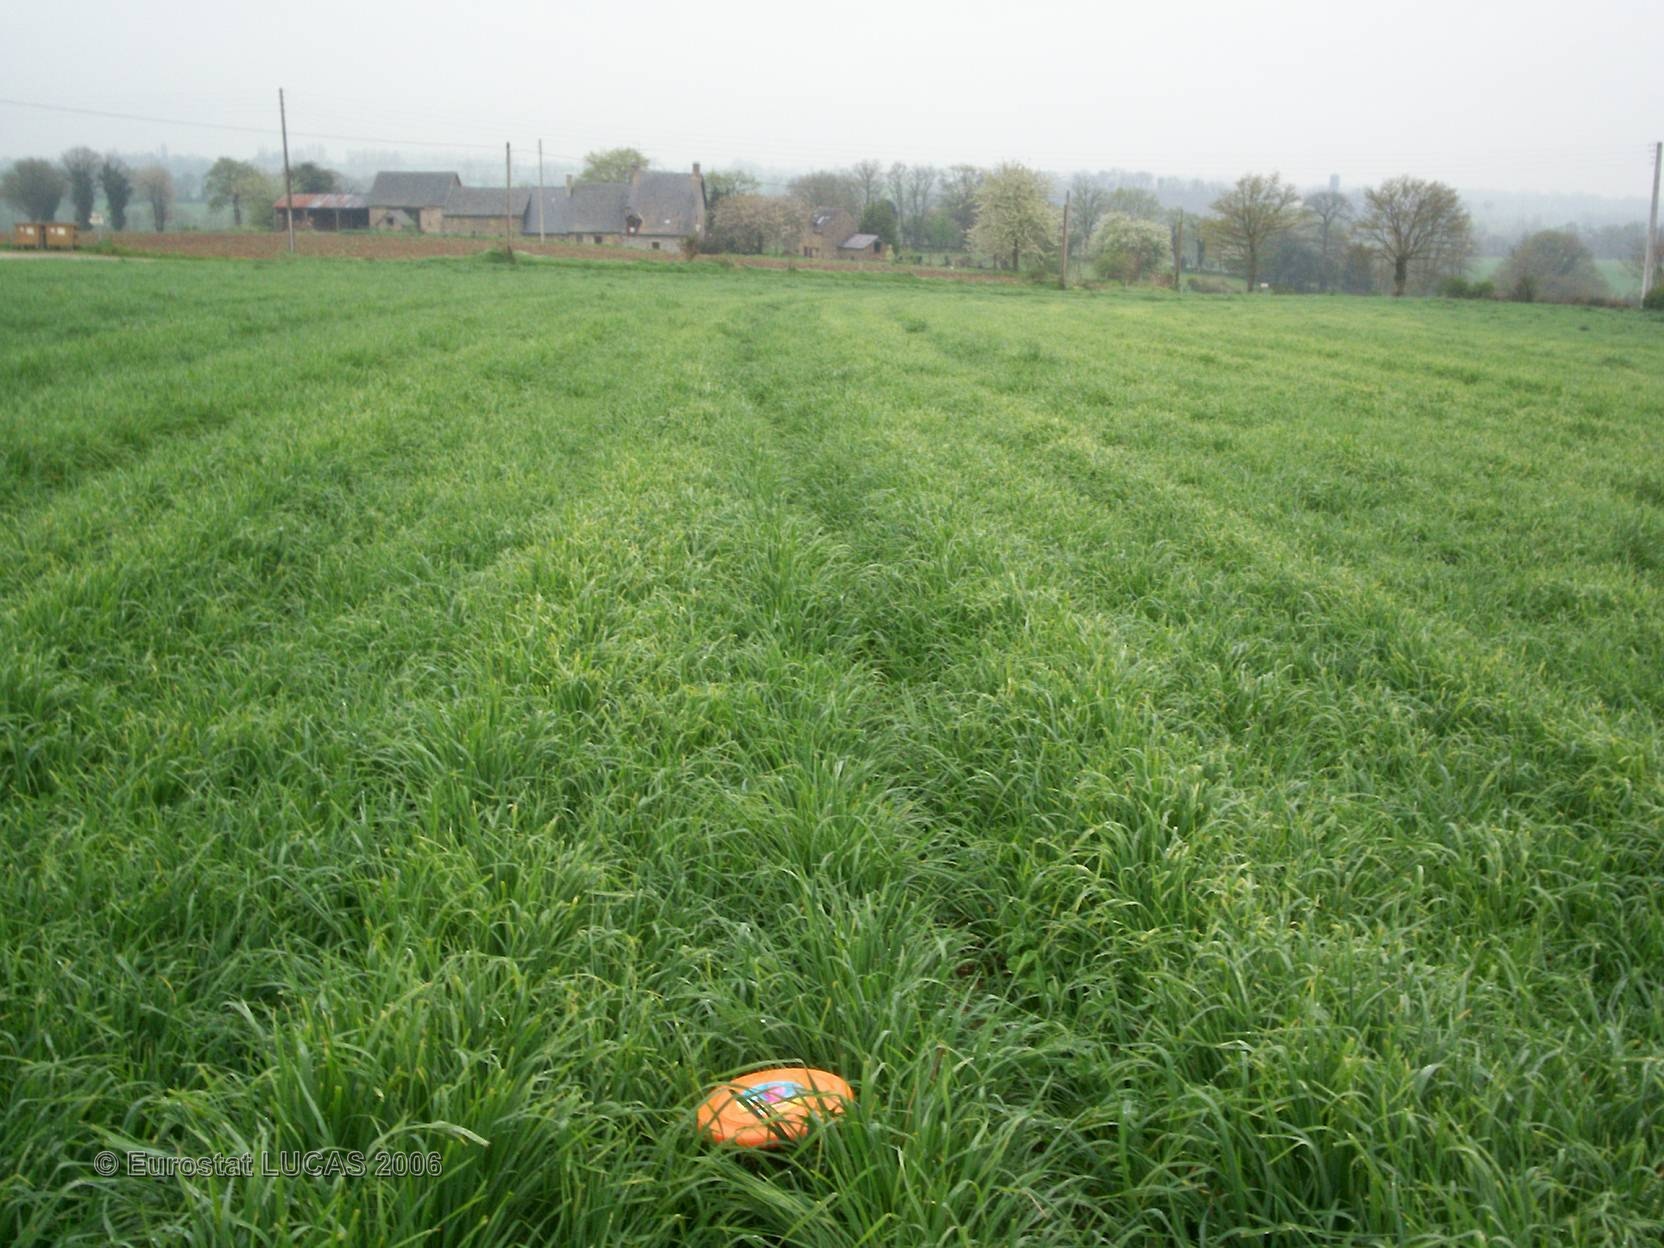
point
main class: Grassland
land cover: Grassland without tree/shrub cover
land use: Agriculture (excluding fallow land and kitchen gardens)
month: April
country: FR
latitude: 48.2494
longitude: -0.6617
